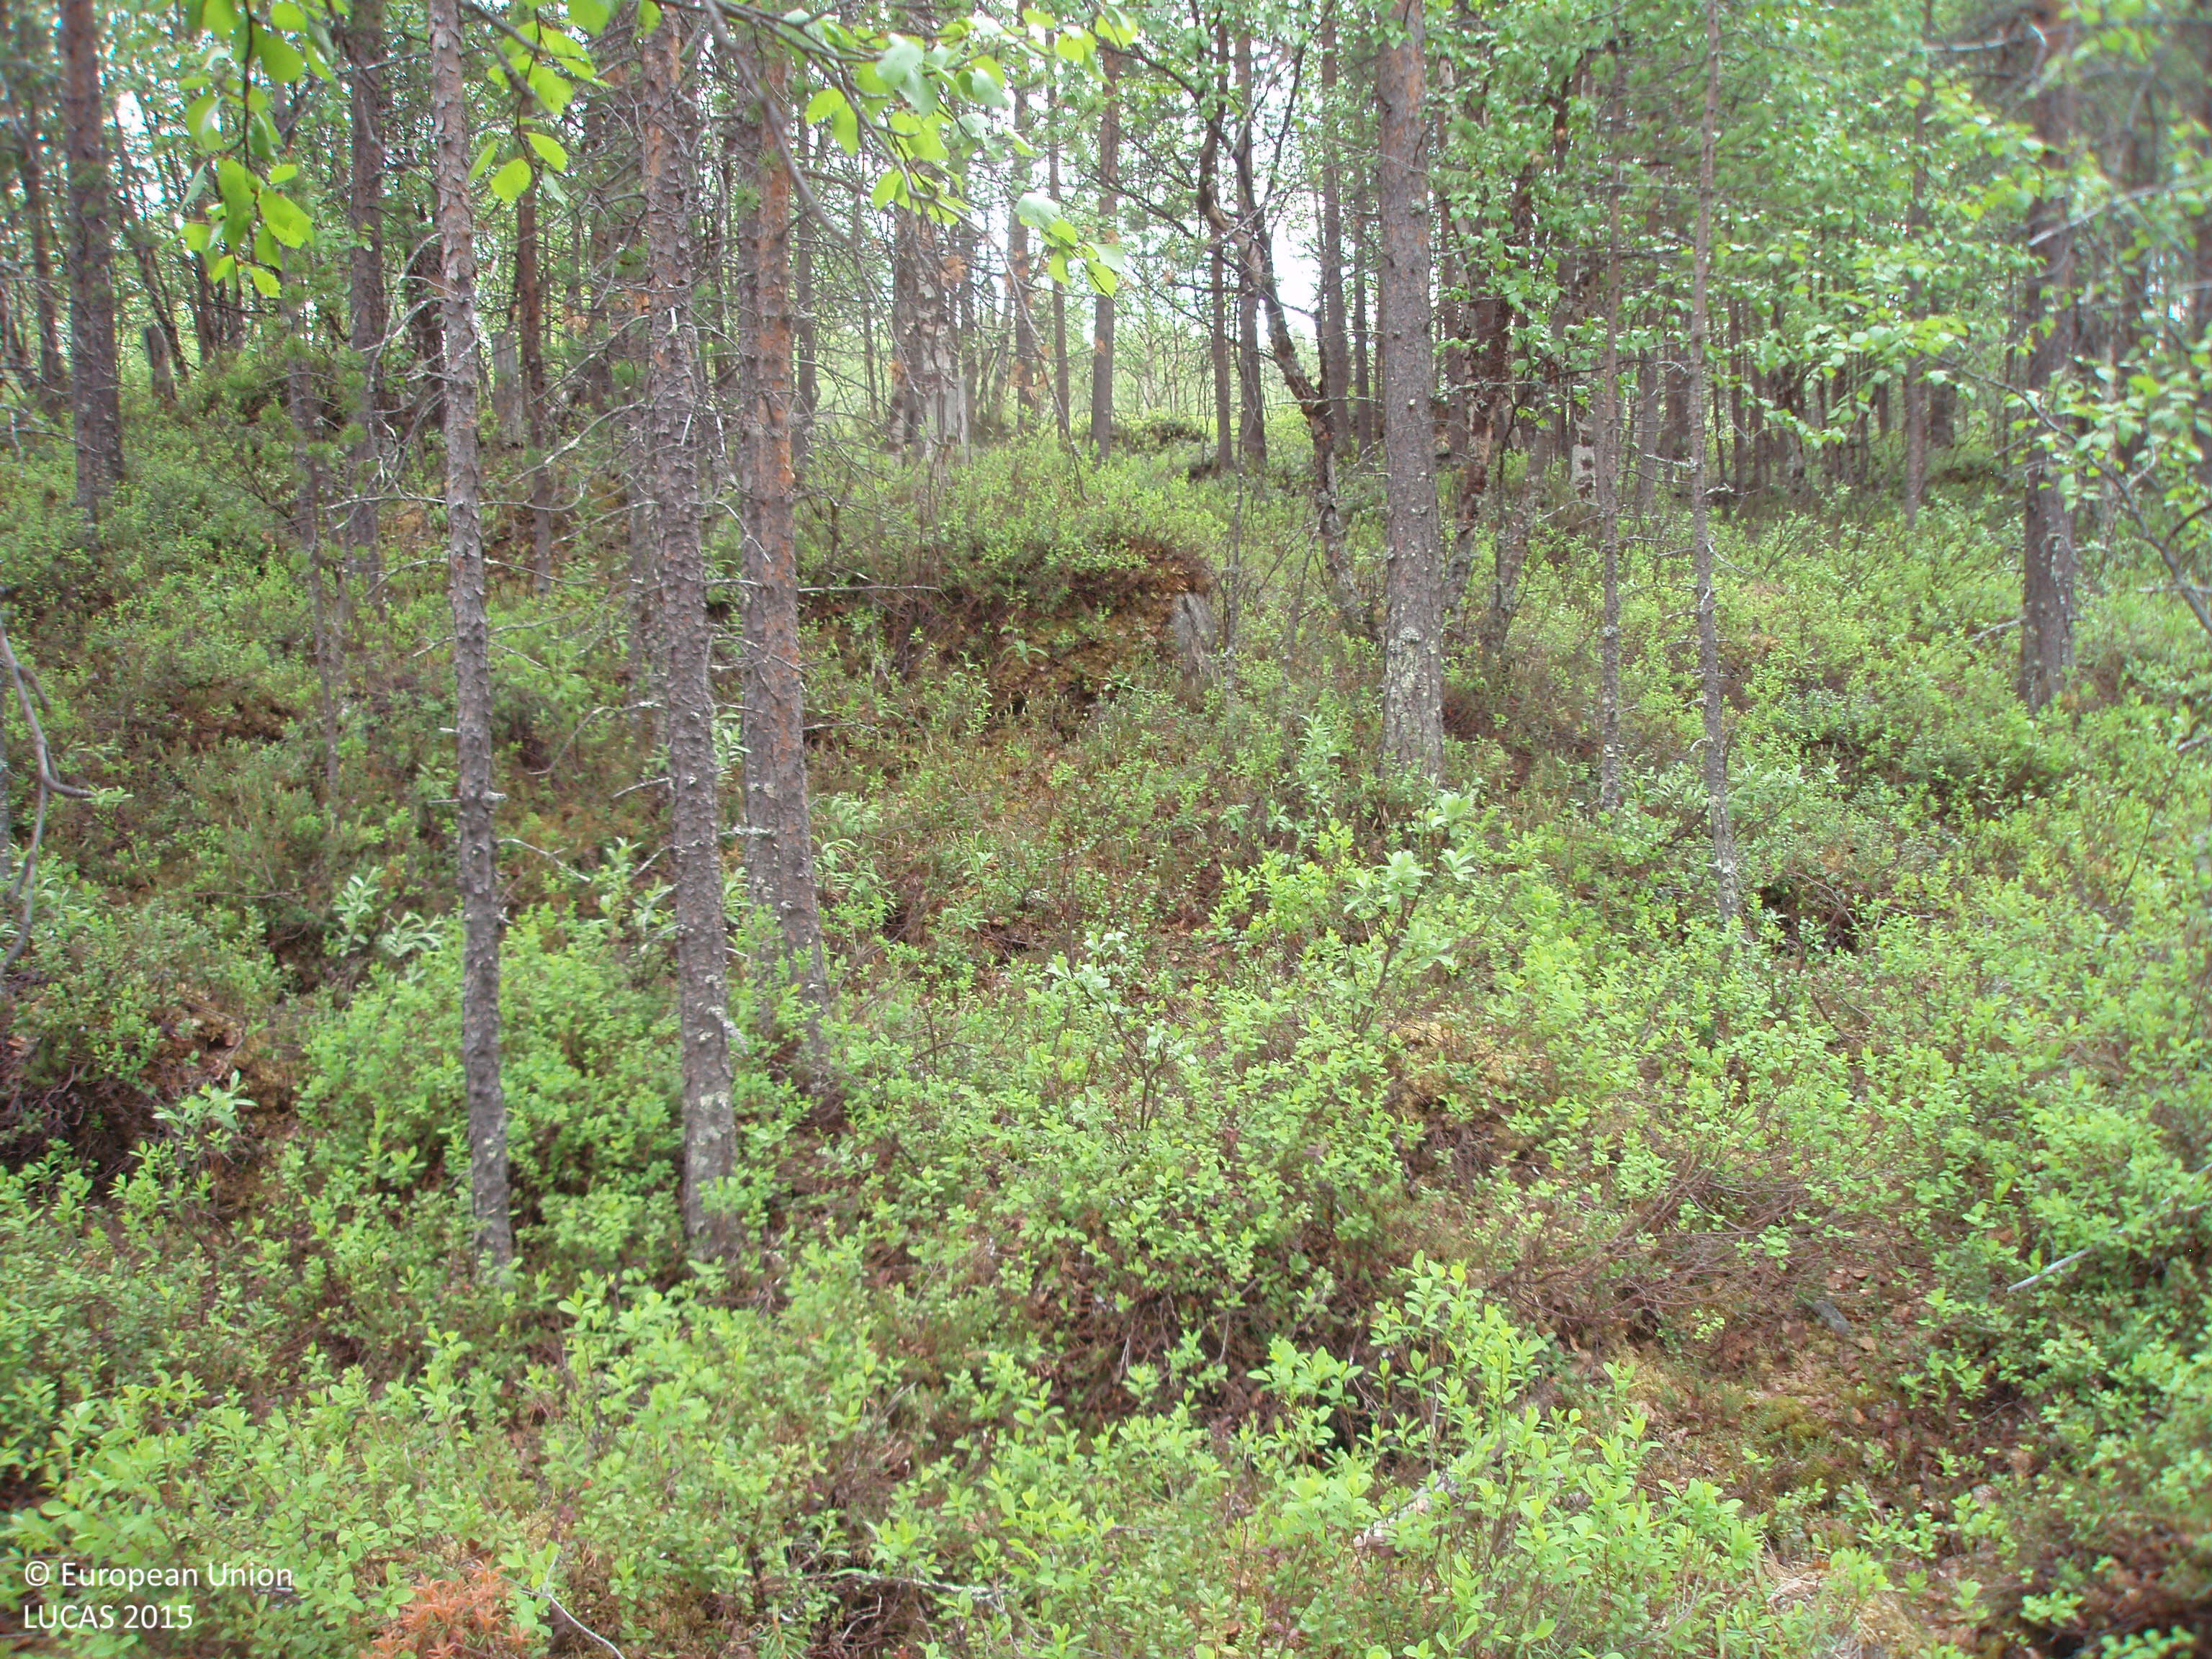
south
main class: Woodland
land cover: Pine dominated mixed woodland
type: boreal forest
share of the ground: > 75 %
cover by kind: coniferous forest trees 45 %, broadleaved forest trees 45 %, shrubs 5 %, unconsolidated bare surface 5 %
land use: Forestry
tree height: > 5 m
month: June
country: FI
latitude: 68.7833
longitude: 28.1435
